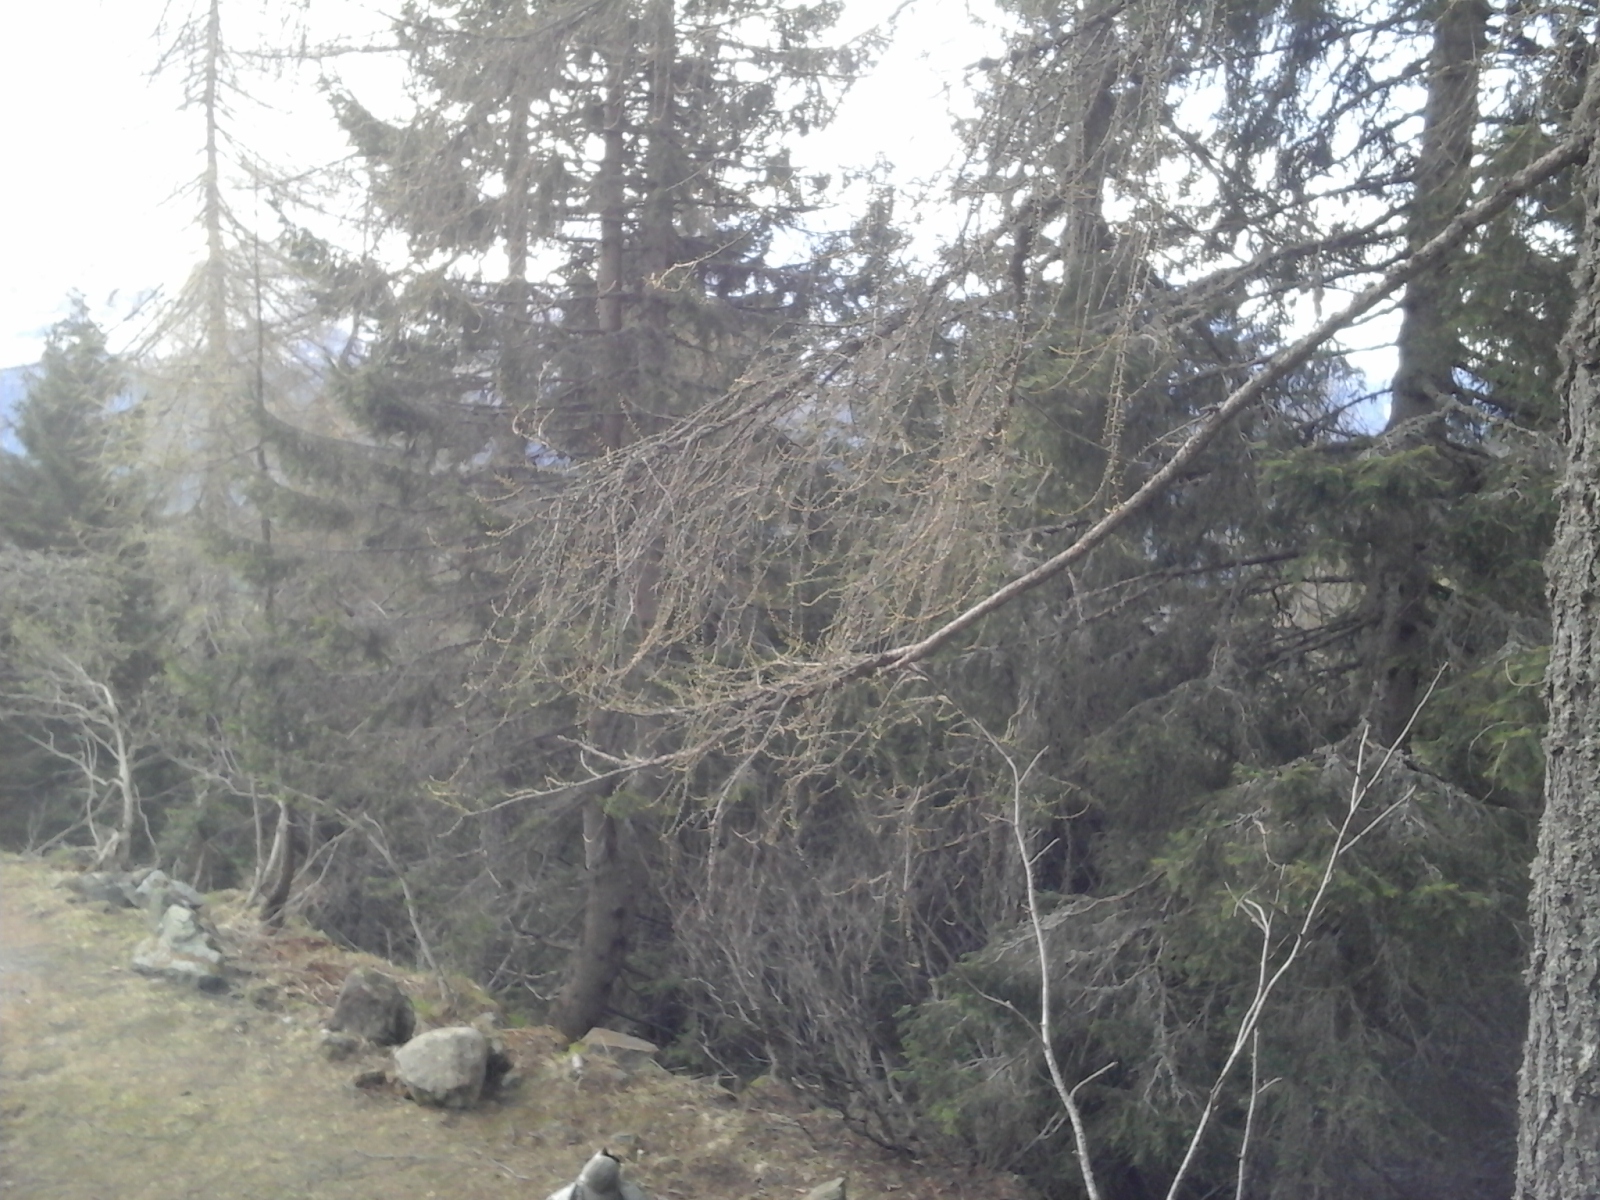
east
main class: Woodland
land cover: Other coniferous woodland
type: alpine coniferous forest
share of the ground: 25 - 50 %
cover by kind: herbaceous plants 50 %, coniferous forest trees 40 %, shrubs 10 %
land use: Forestry
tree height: > 5 m
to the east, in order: Other coniferous woodland
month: May
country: IT
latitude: 46.2045
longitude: 10.7377
